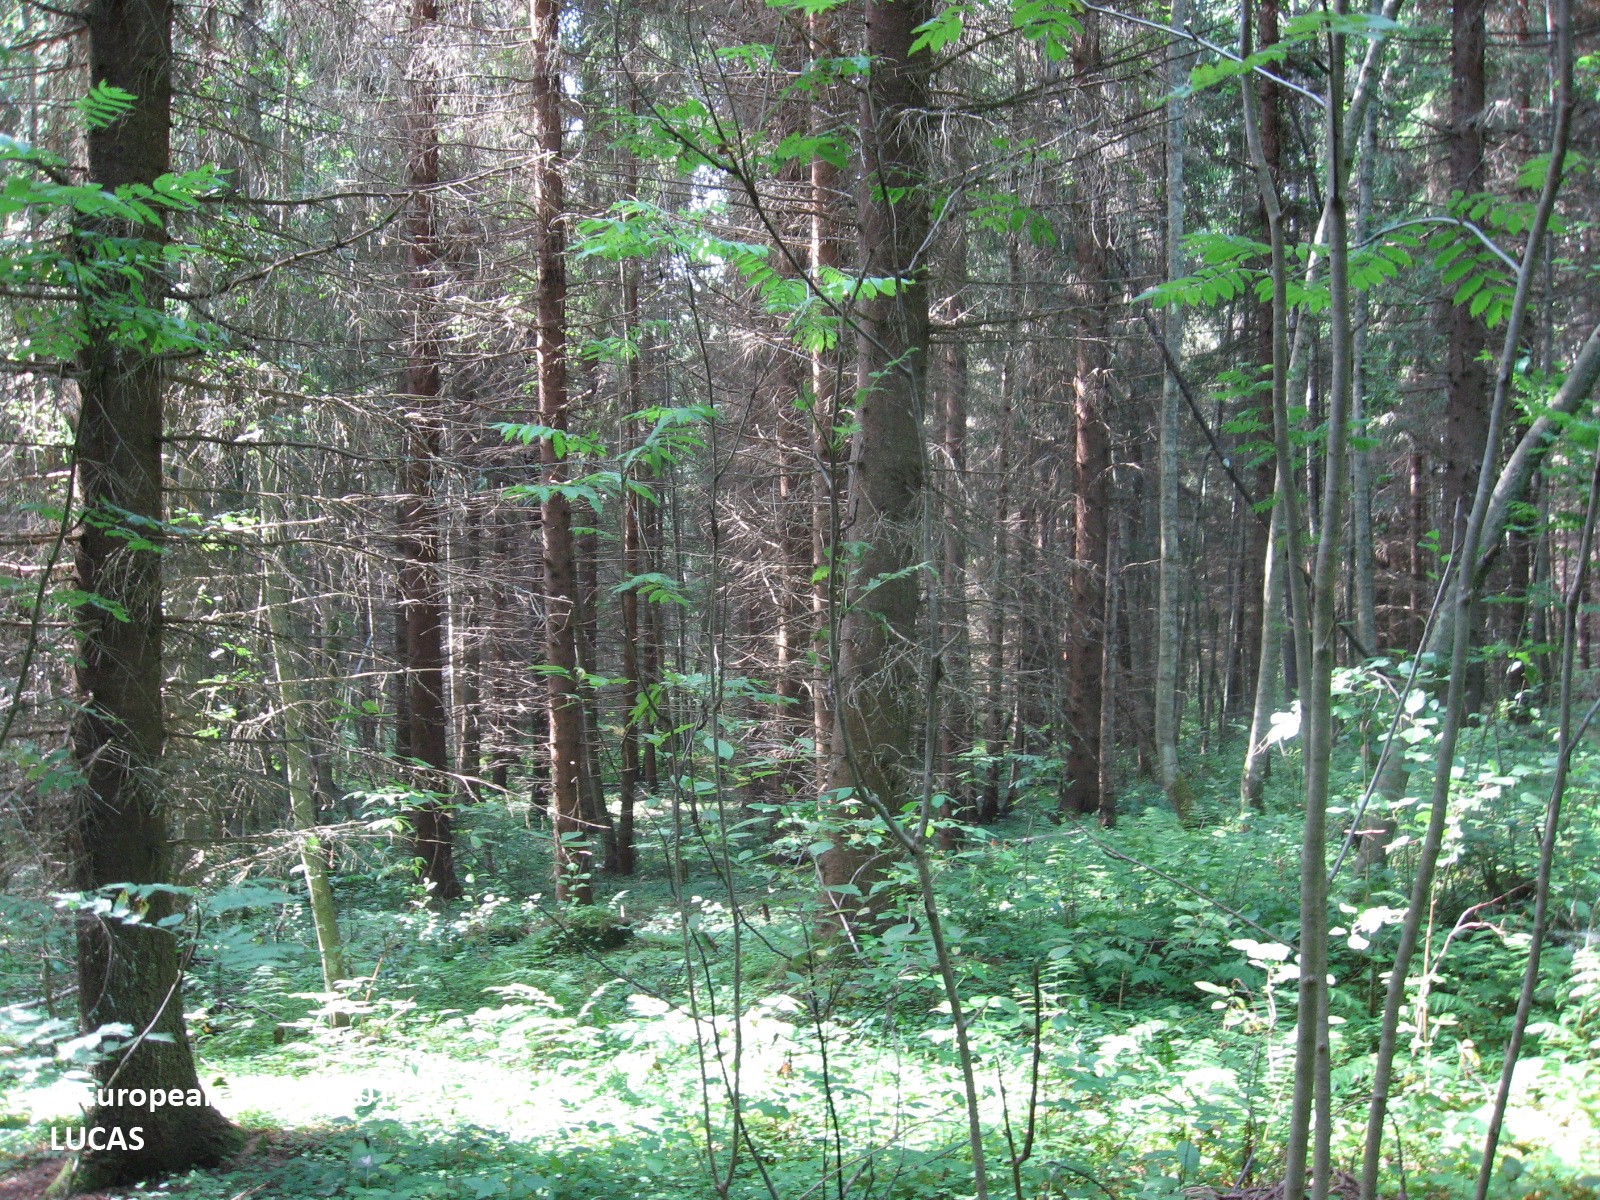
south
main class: Woodland
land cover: Spruce dominated coniferous woodland
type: boreal forest
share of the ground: > 75 %
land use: Forestry
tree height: > 5 m
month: August
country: FI
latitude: 61.5403
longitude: 25.8750
